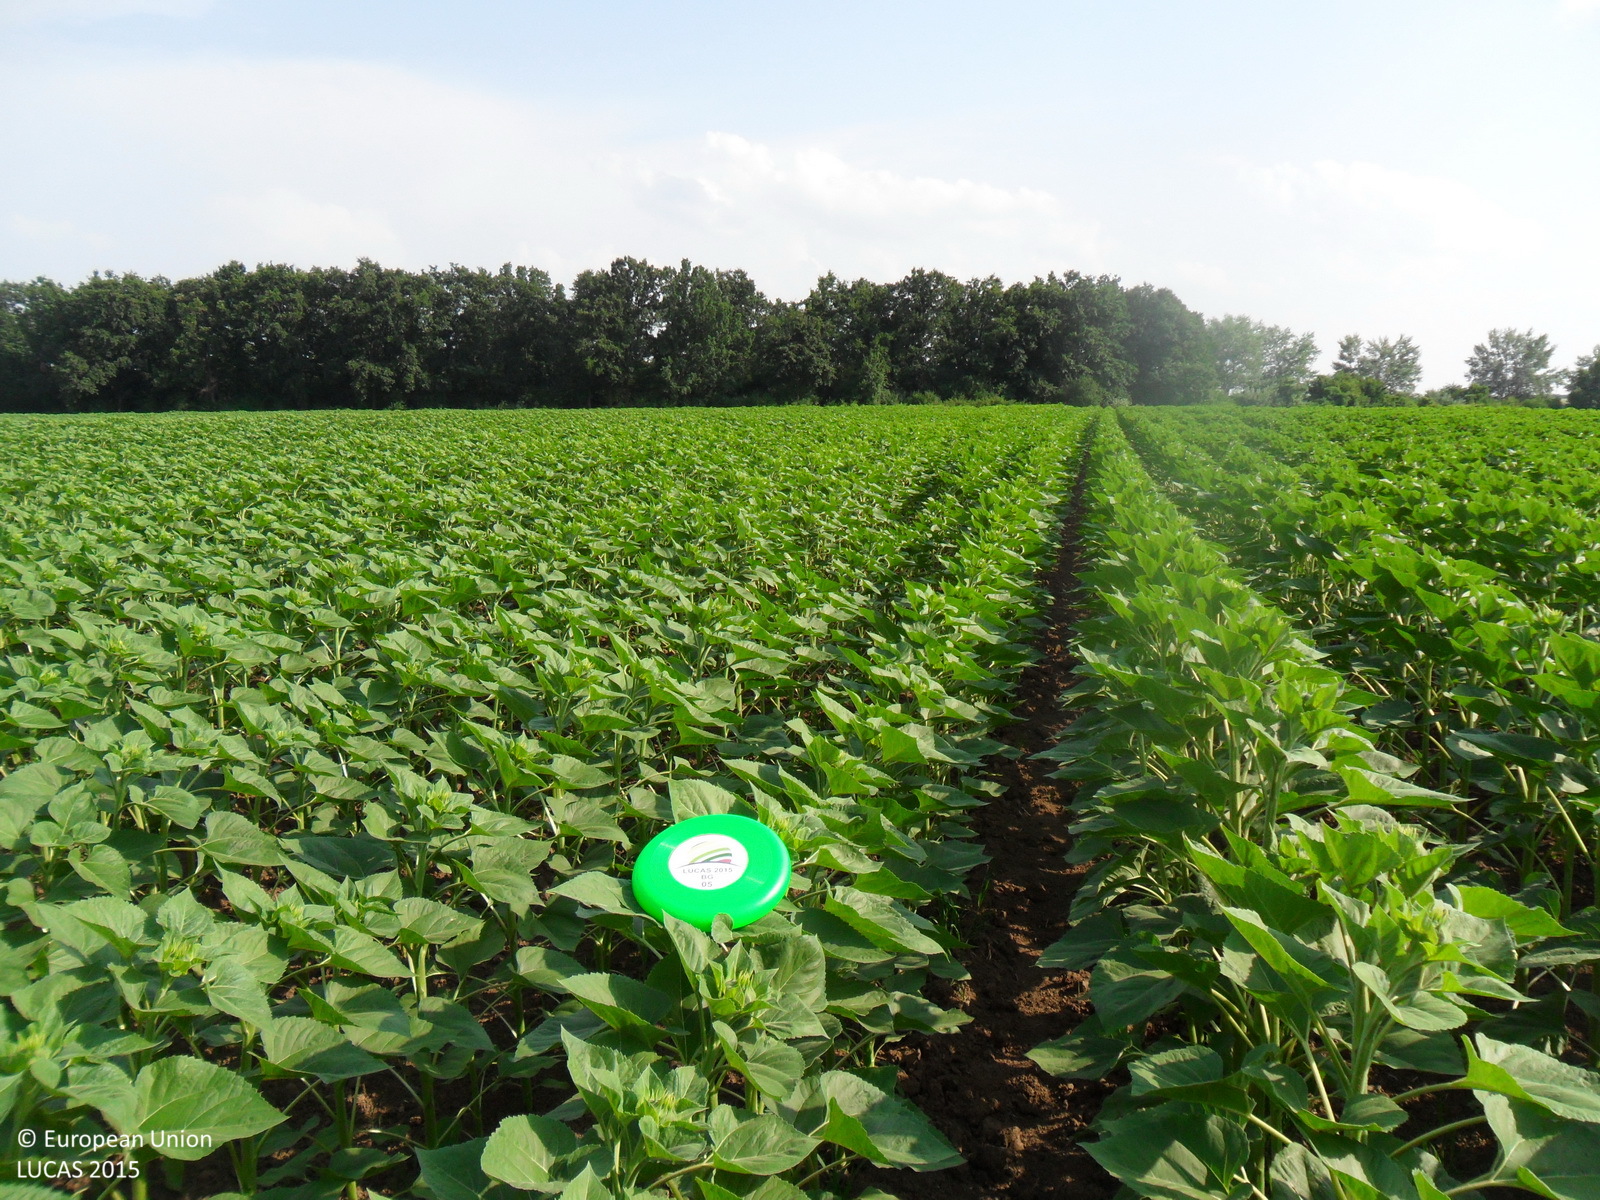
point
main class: Cropland
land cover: Sunflower
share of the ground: > 75 %
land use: Agriculture (excluding fallow land and kitchen gardens)
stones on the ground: < 10 %
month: June
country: BG
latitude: 43.7308
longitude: 26.8642
